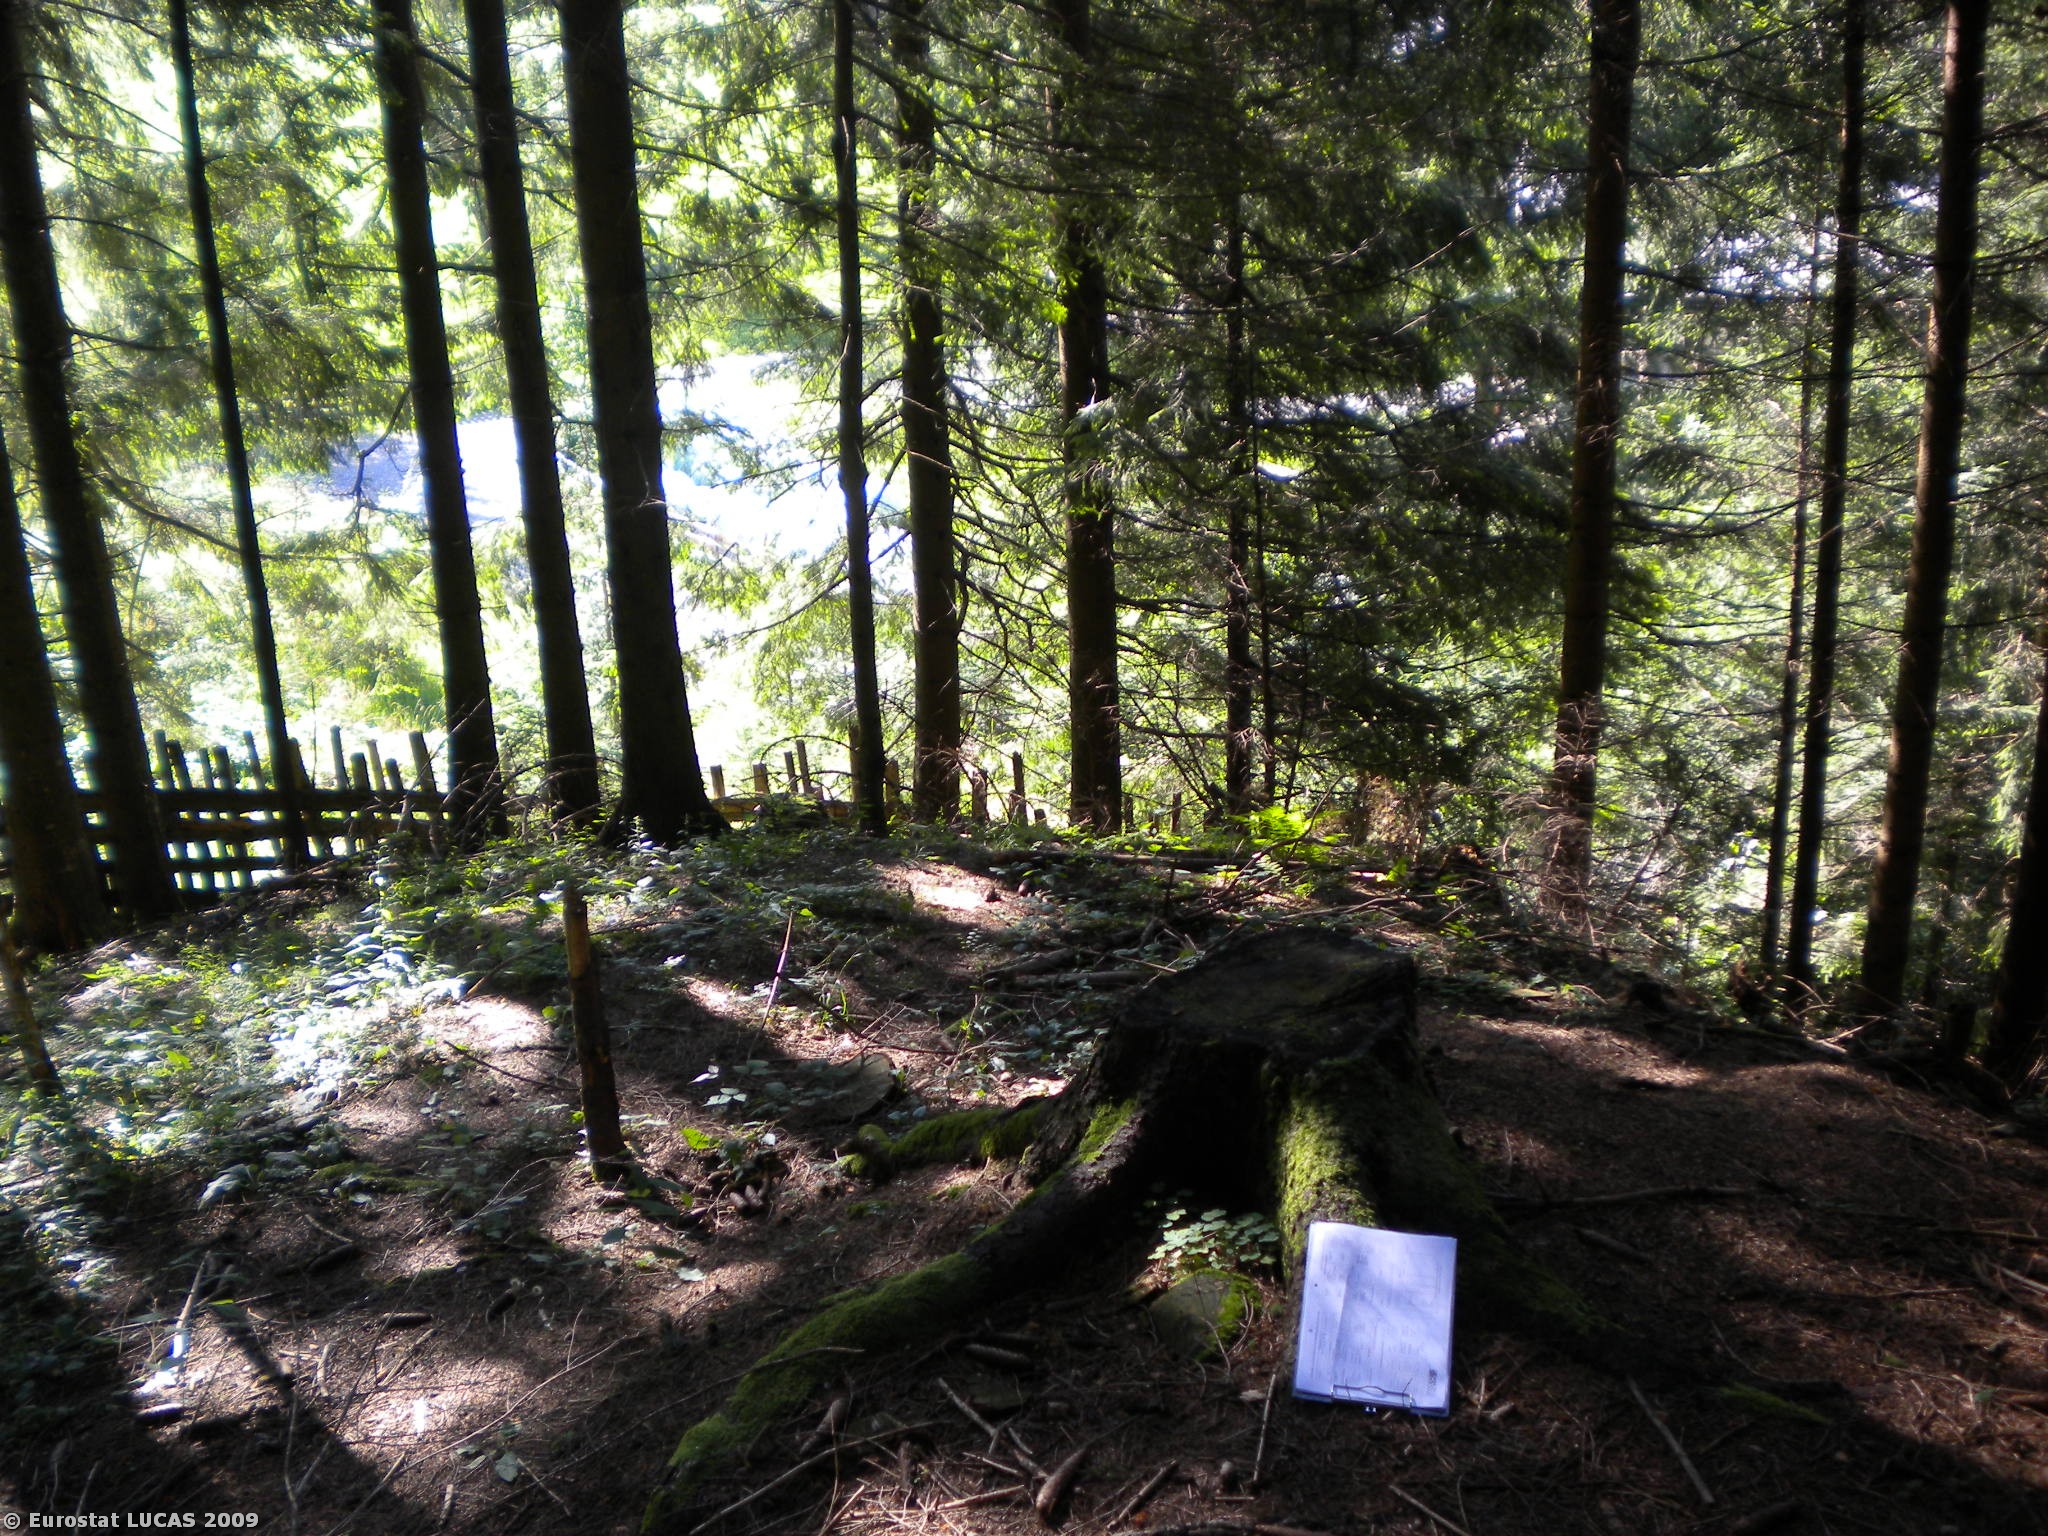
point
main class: Woodland
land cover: Coniferous woodland
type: alpine coniferous forest
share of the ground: > 75 %
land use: Forestry
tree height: > 5 m
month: July
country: AT
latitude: 46.6302
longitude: 13.1189
